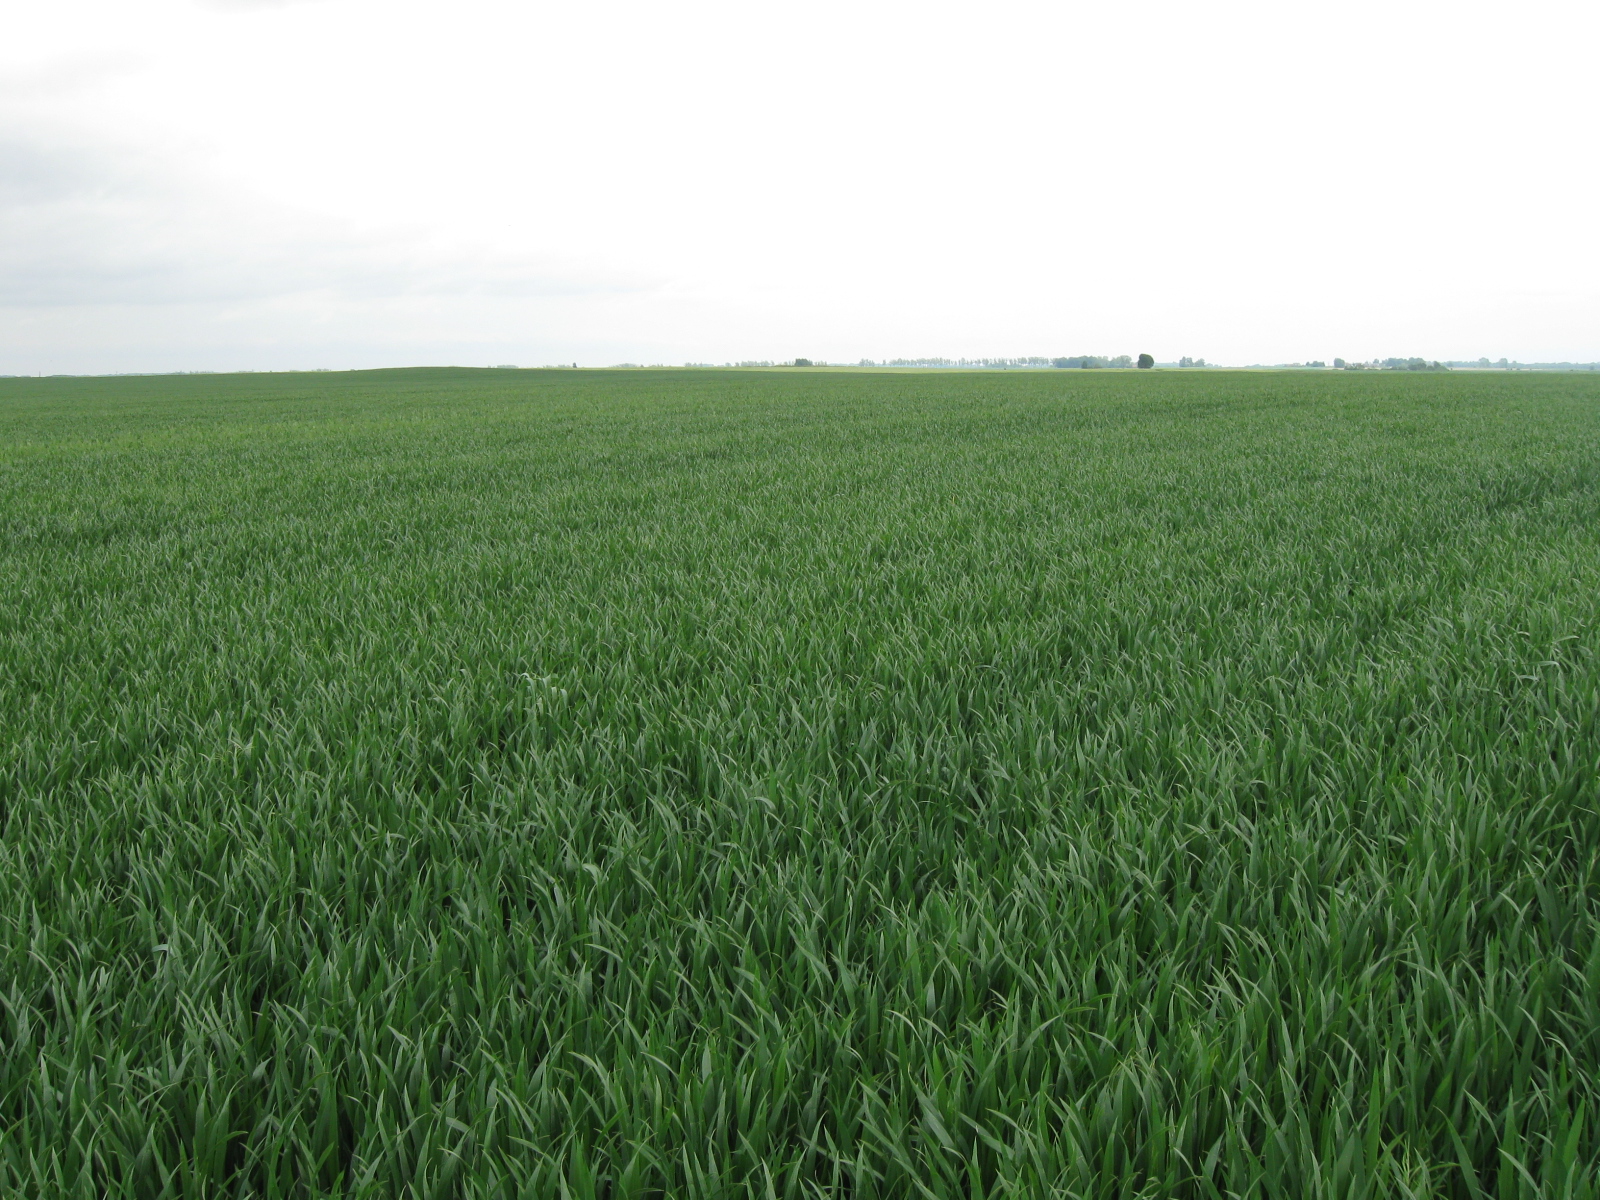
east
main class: Cropland
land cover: Common wheat
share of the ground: > 75 %
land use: Agriculture (excluding fallow land and kitchen gardens)
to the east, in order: Common wheat
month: May
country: LT
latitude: 54.6831
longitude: 22.8345
